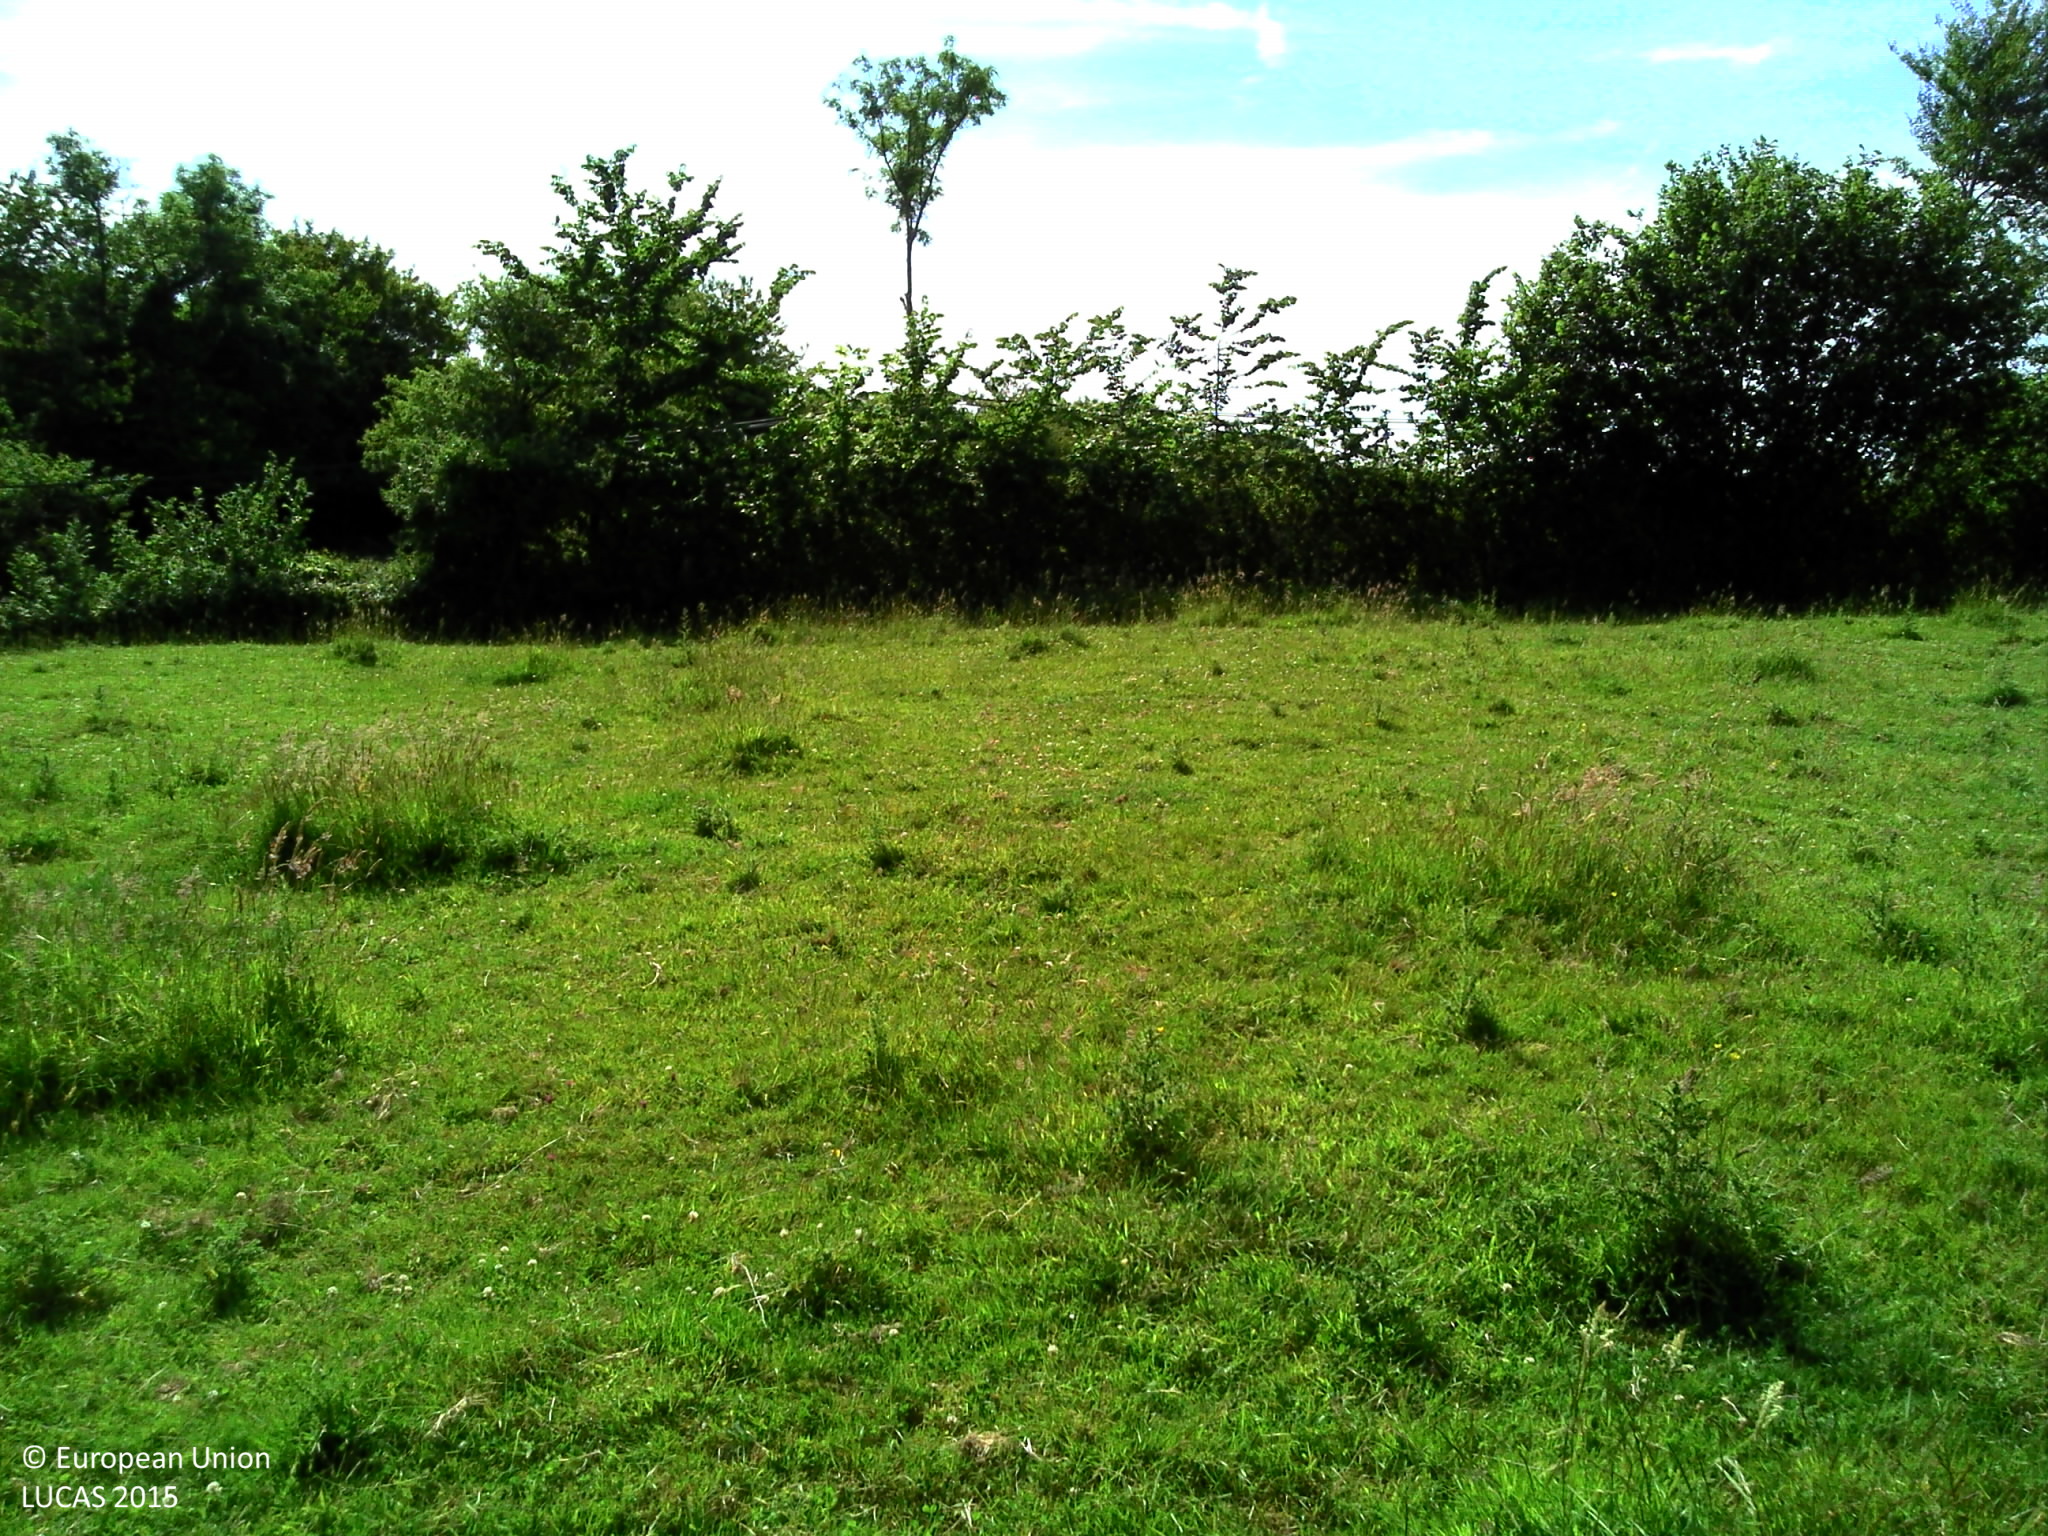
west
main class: Grassland
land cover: Grassland without tree/shrub cover
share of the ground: > 75 %
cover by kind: herbaceous plants 100 %
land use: Agriculture (excluding fallow land and kitchen gardens)
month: June
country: FR
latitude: 49.1752
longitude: -1.3914
